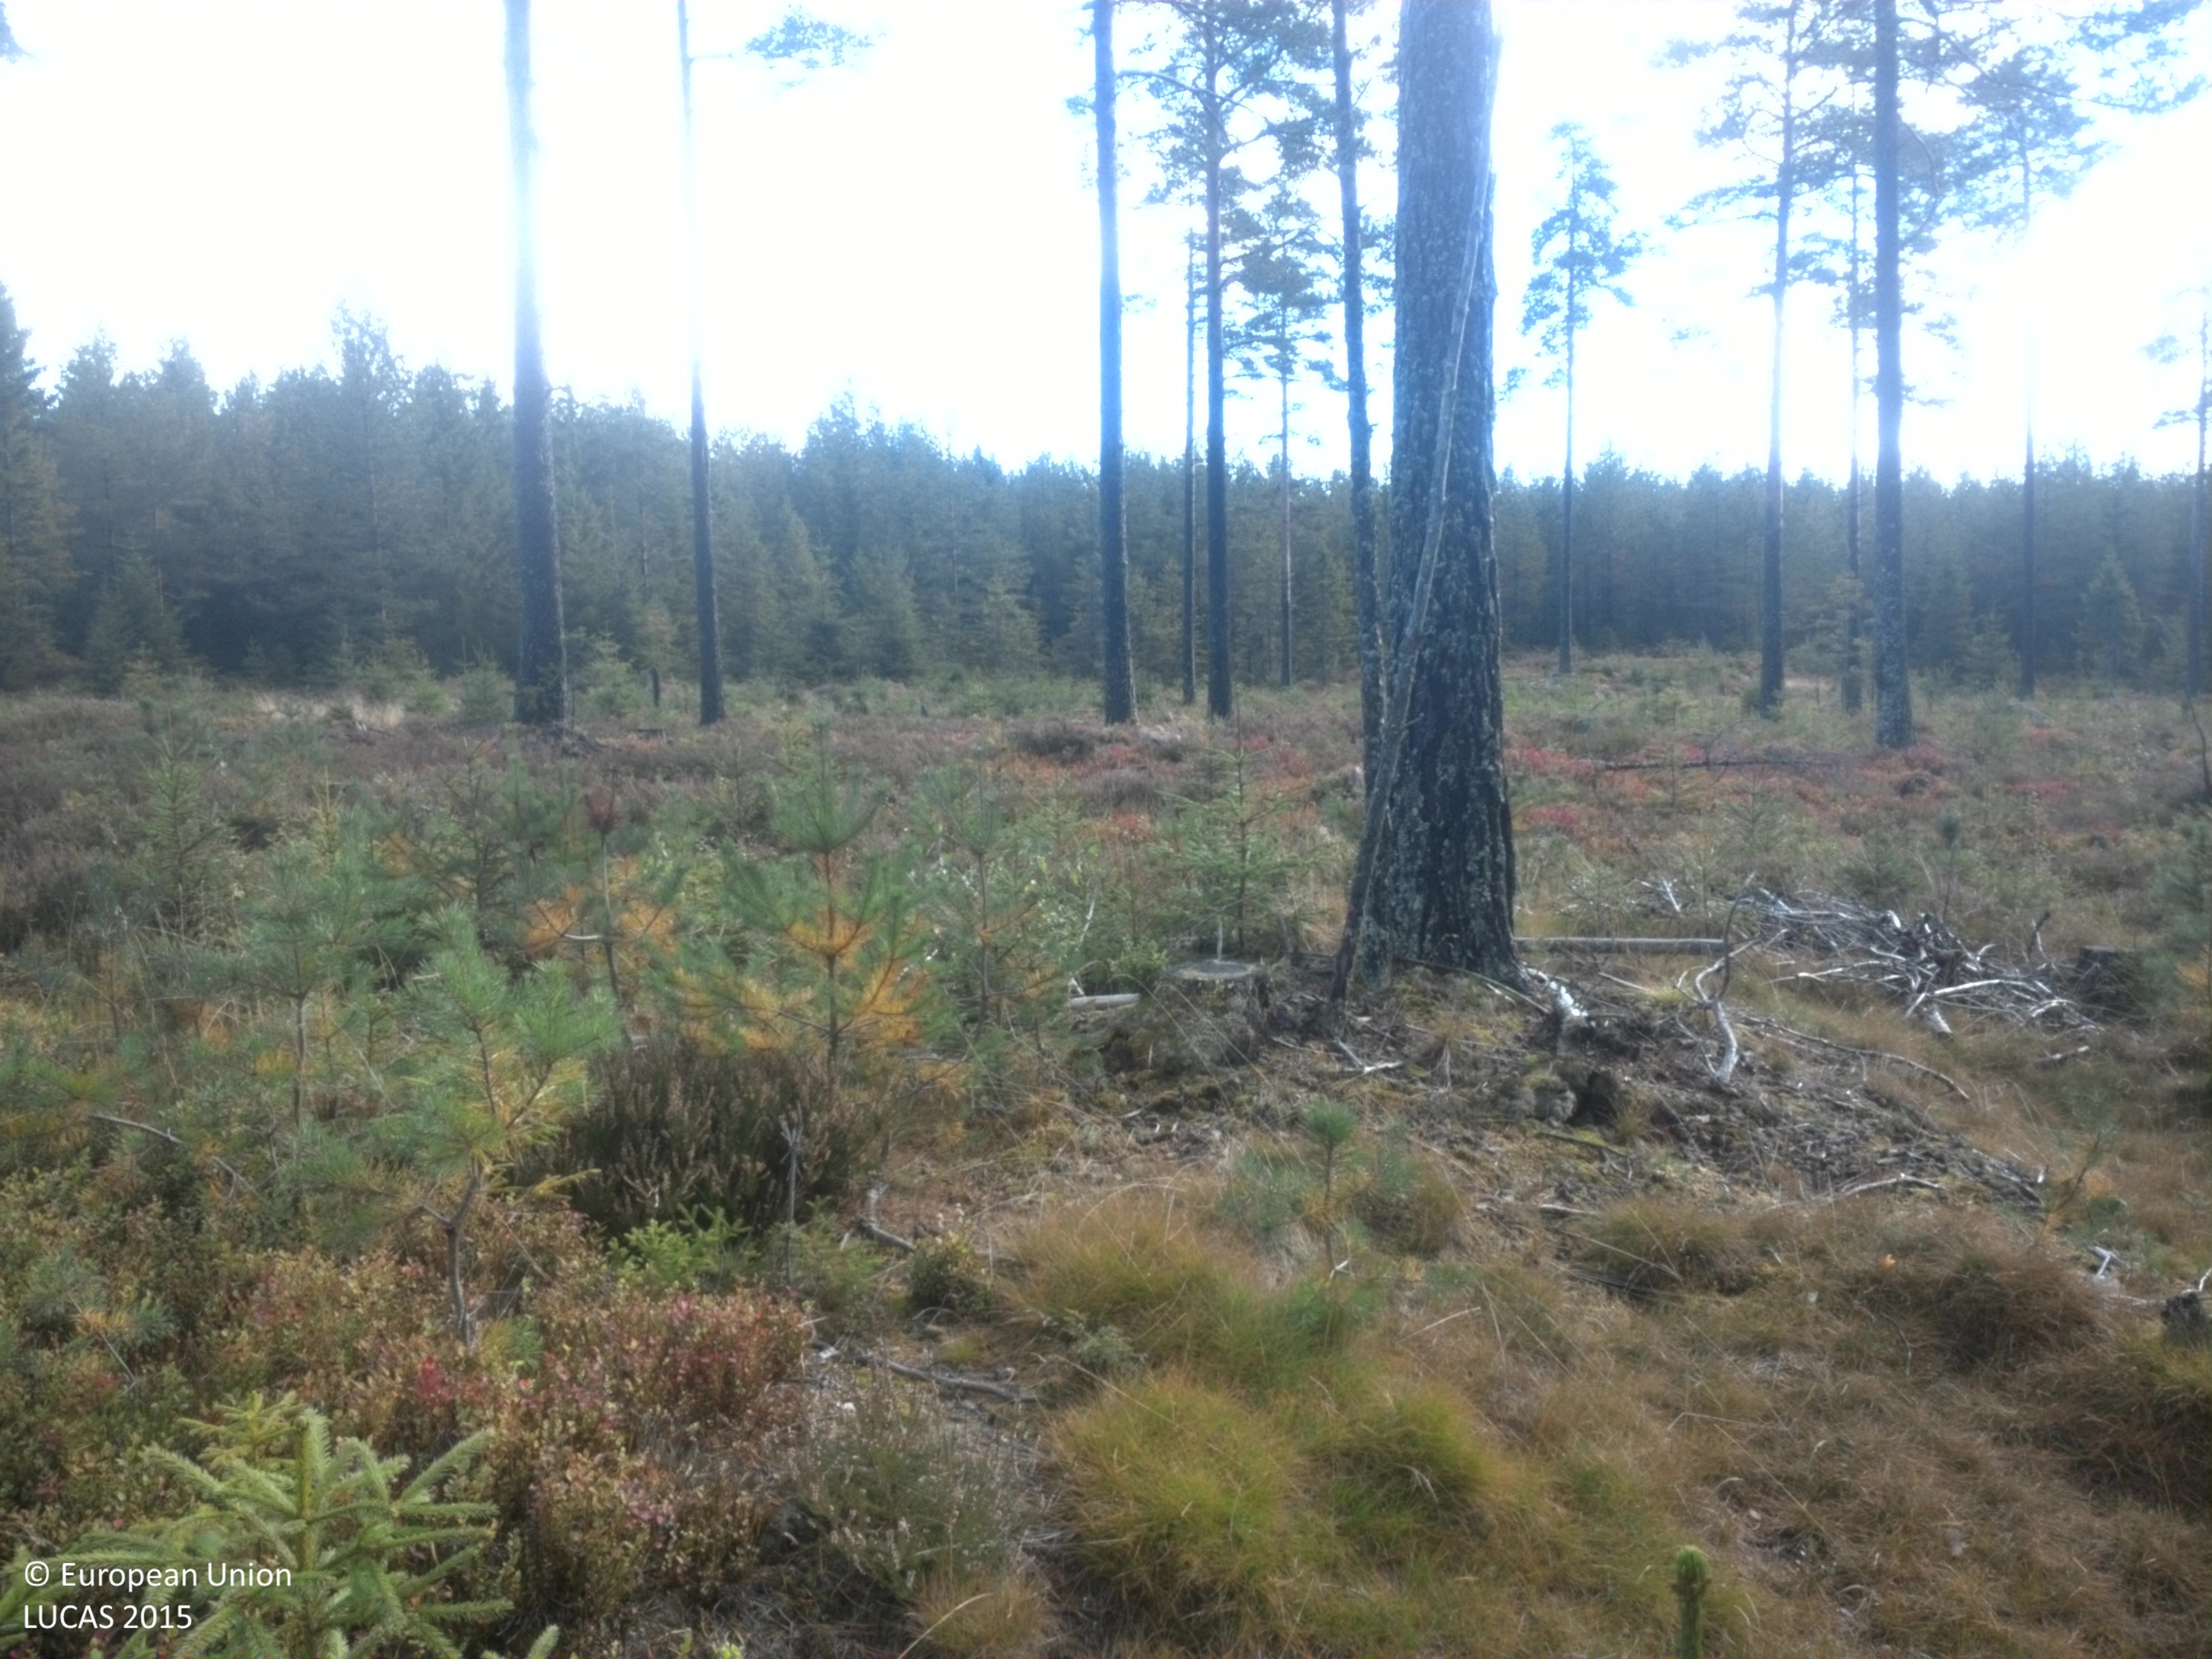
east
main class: Woodland
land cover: Other coniferous woodland
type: boreal forest
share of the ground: 50 - 75 %
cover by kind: coniferous forest trees 60 %, shrubs 30 %, herbaceous plants 10 %
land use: Forestry
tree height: > 5 m
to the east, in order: Other coniferous woodland; Pine dominated coniferous woodland
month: September
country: SE
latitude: 59.8566
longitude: 15.5065
